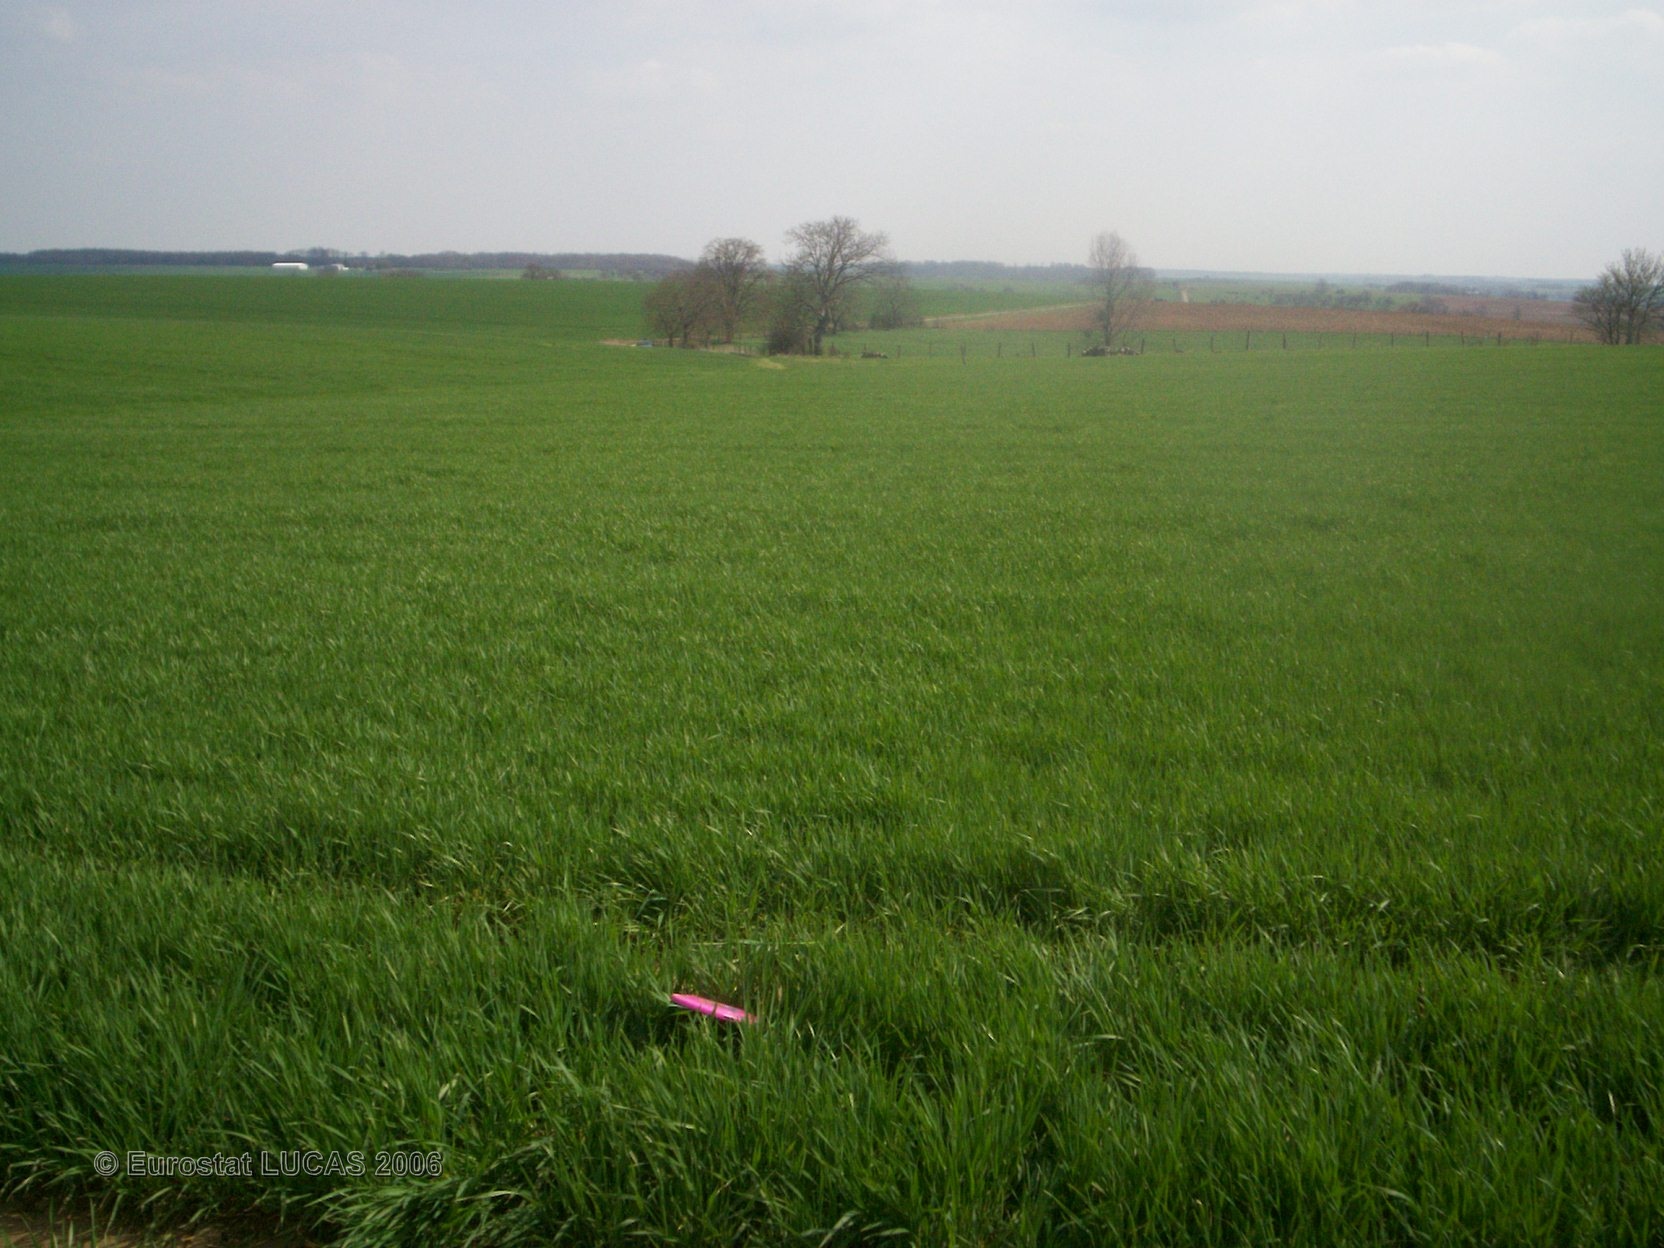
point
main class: Cropland
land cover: Barley
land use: Agriculture (excluding fallow land and kitchen gardens)
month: April
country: FR
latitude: 48.8742
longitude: 5.1581
